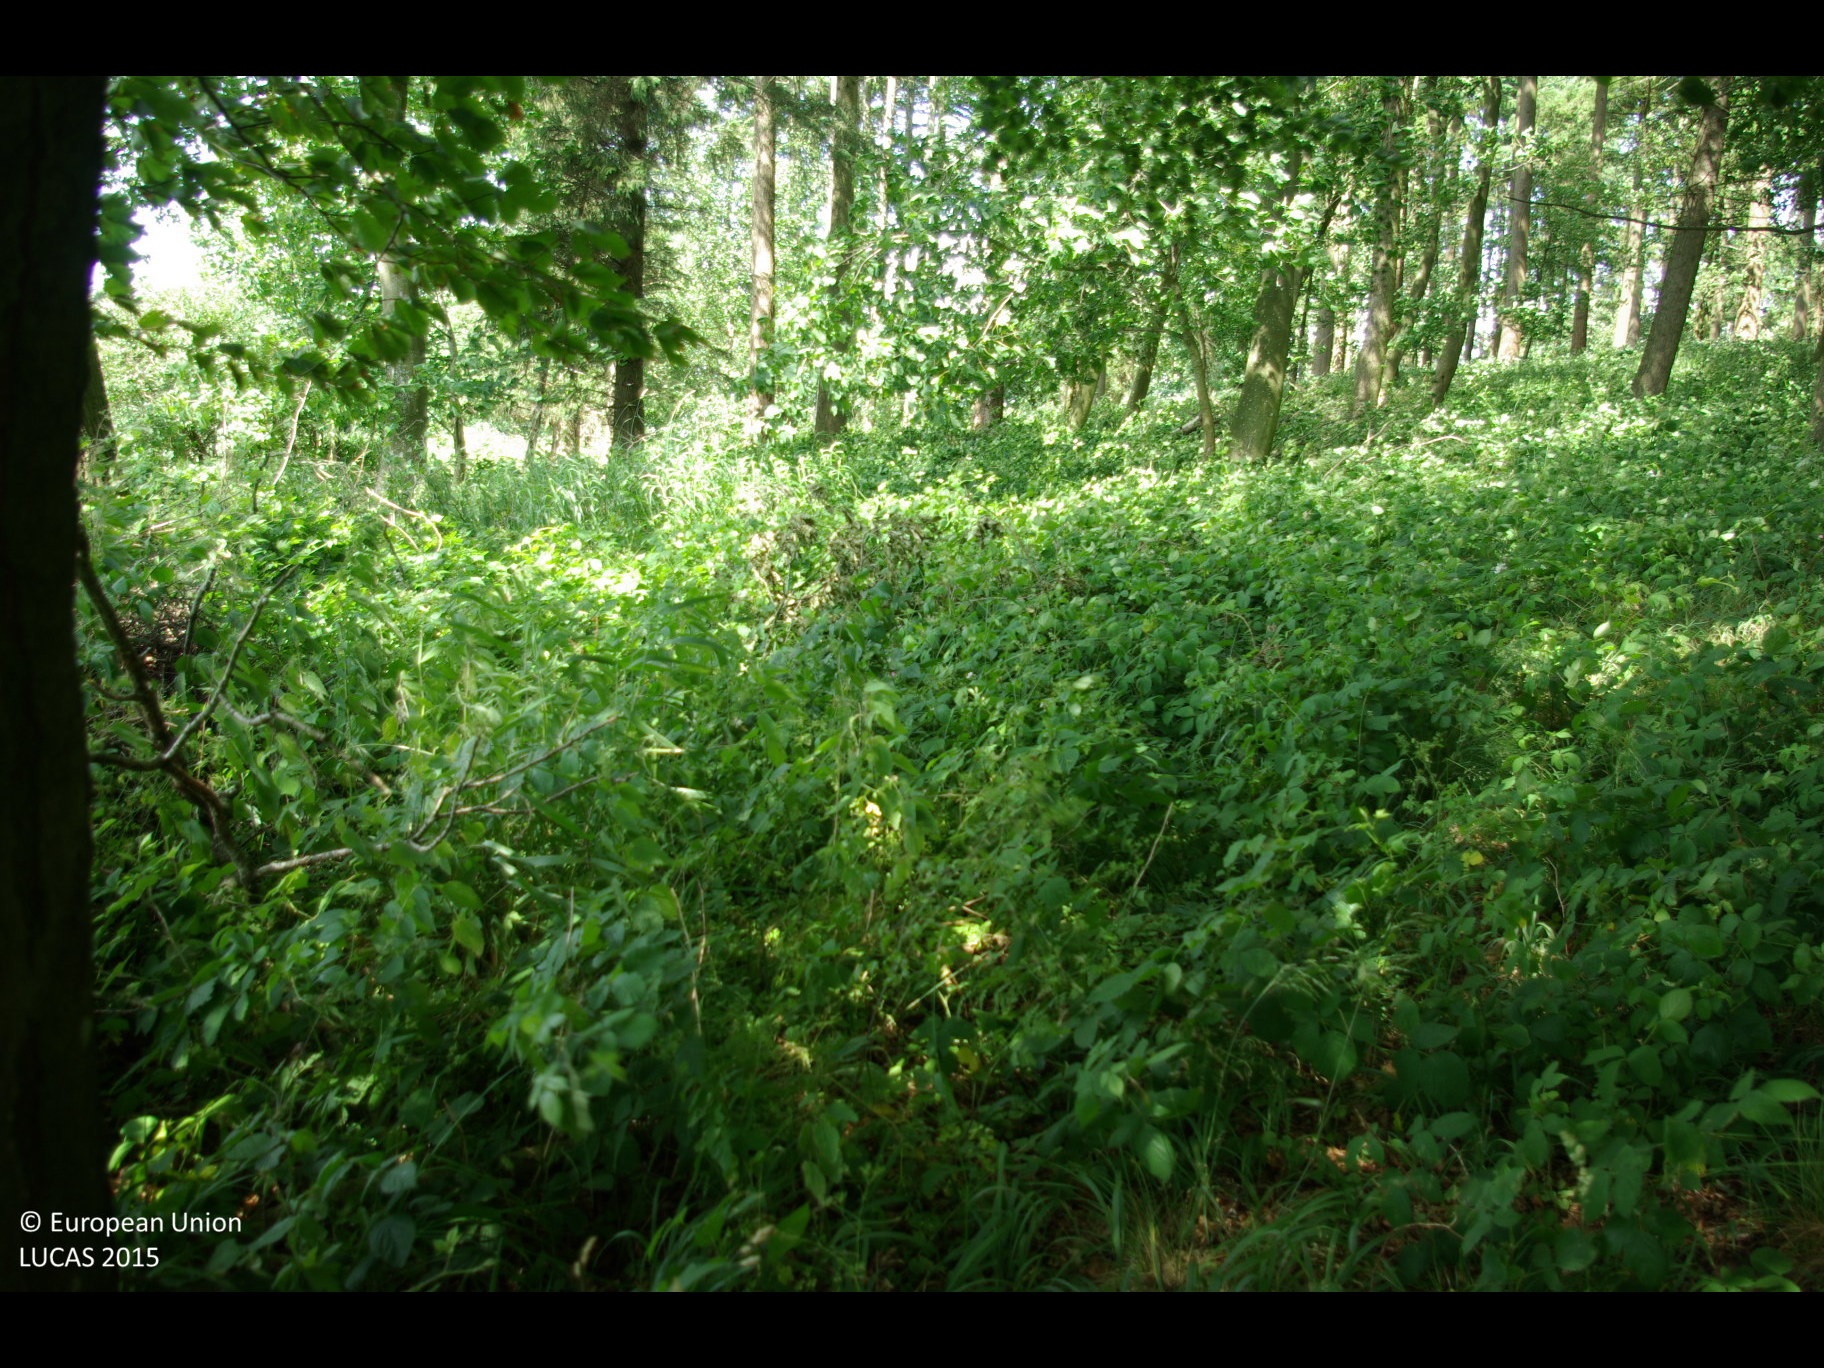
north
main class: Woodland
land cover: Other mixed woodland
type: hemiboreal forest and nemoral coniferous forest and mixed broadleaved-coniferous forest
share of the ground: > 75 %
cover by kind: coniferous forest trees 40 %, broadleaved forest trees 40 %, herbaceous plants 20 %
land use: Forestry
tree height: > 5 m
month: July
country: DE
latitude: 54.5701
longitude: 9.8918
